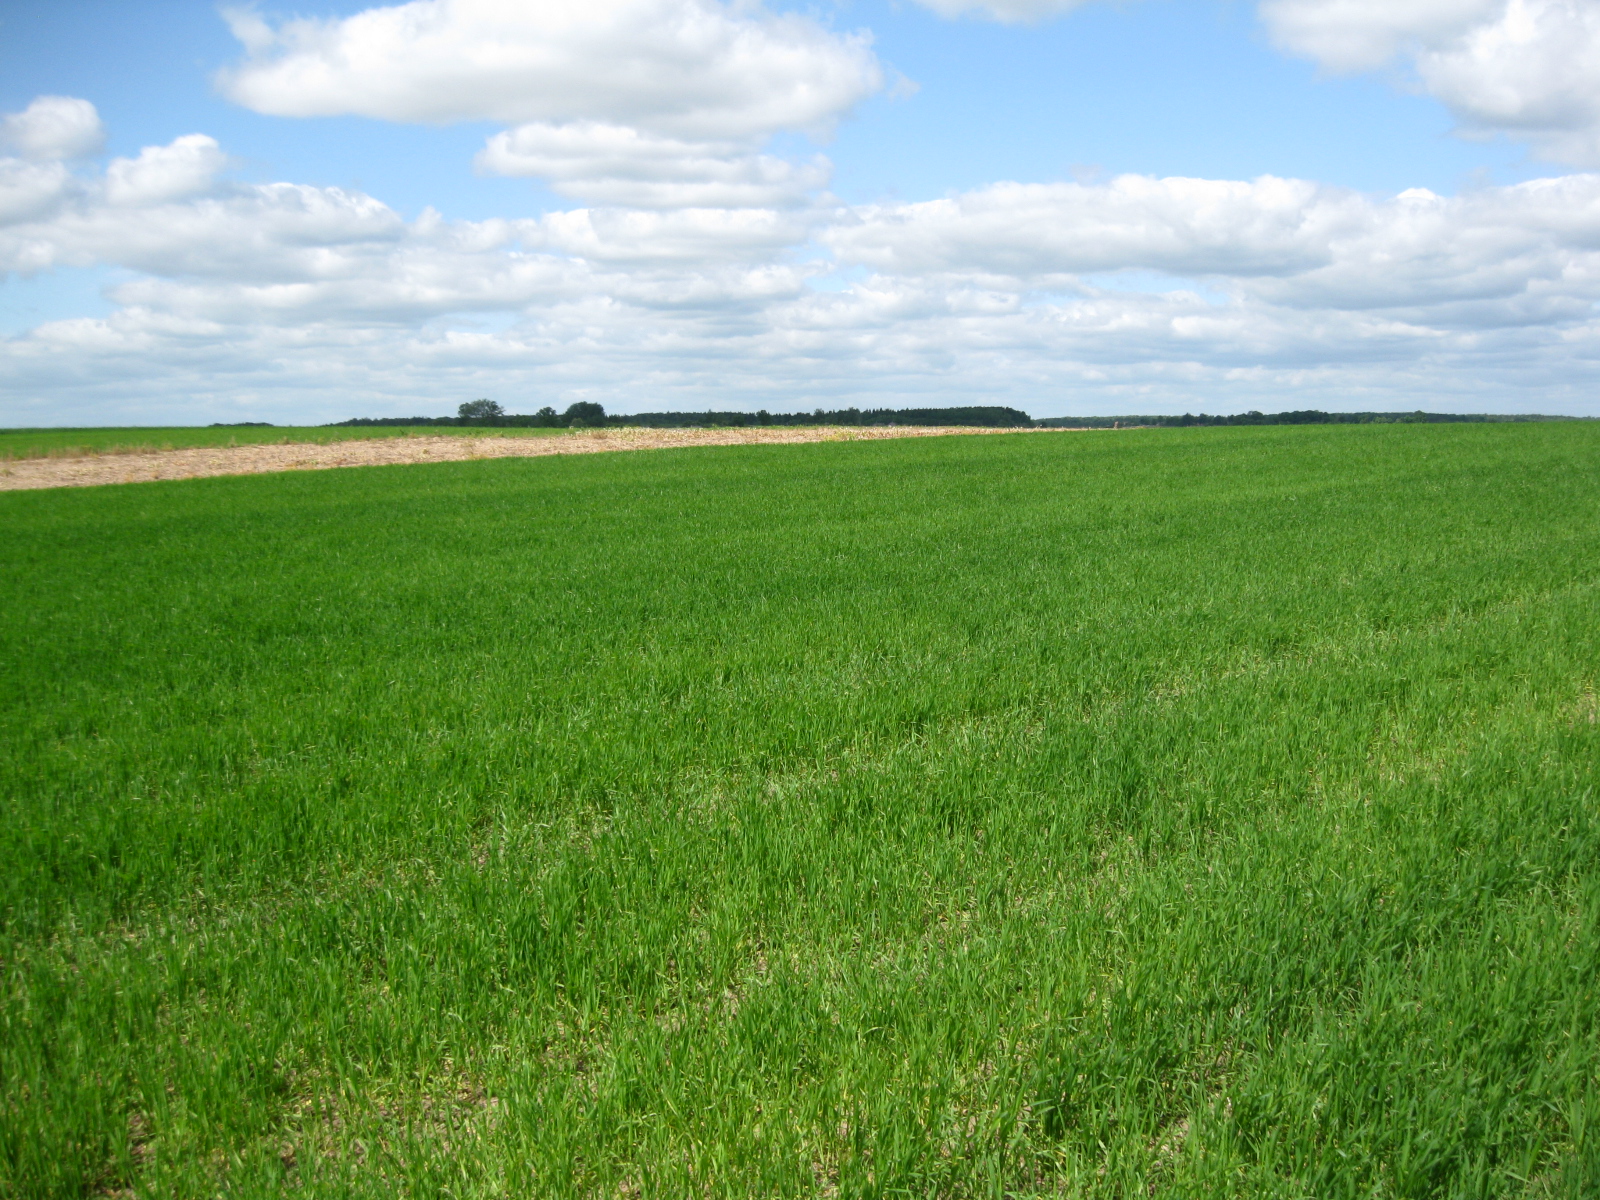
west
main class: Cropland
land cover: Triticale
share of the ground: > 75 %
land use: Agriculture (excluding fallow land and kitchen gardens)
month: June
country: LT
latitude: 55.6827
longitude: 23.3883
